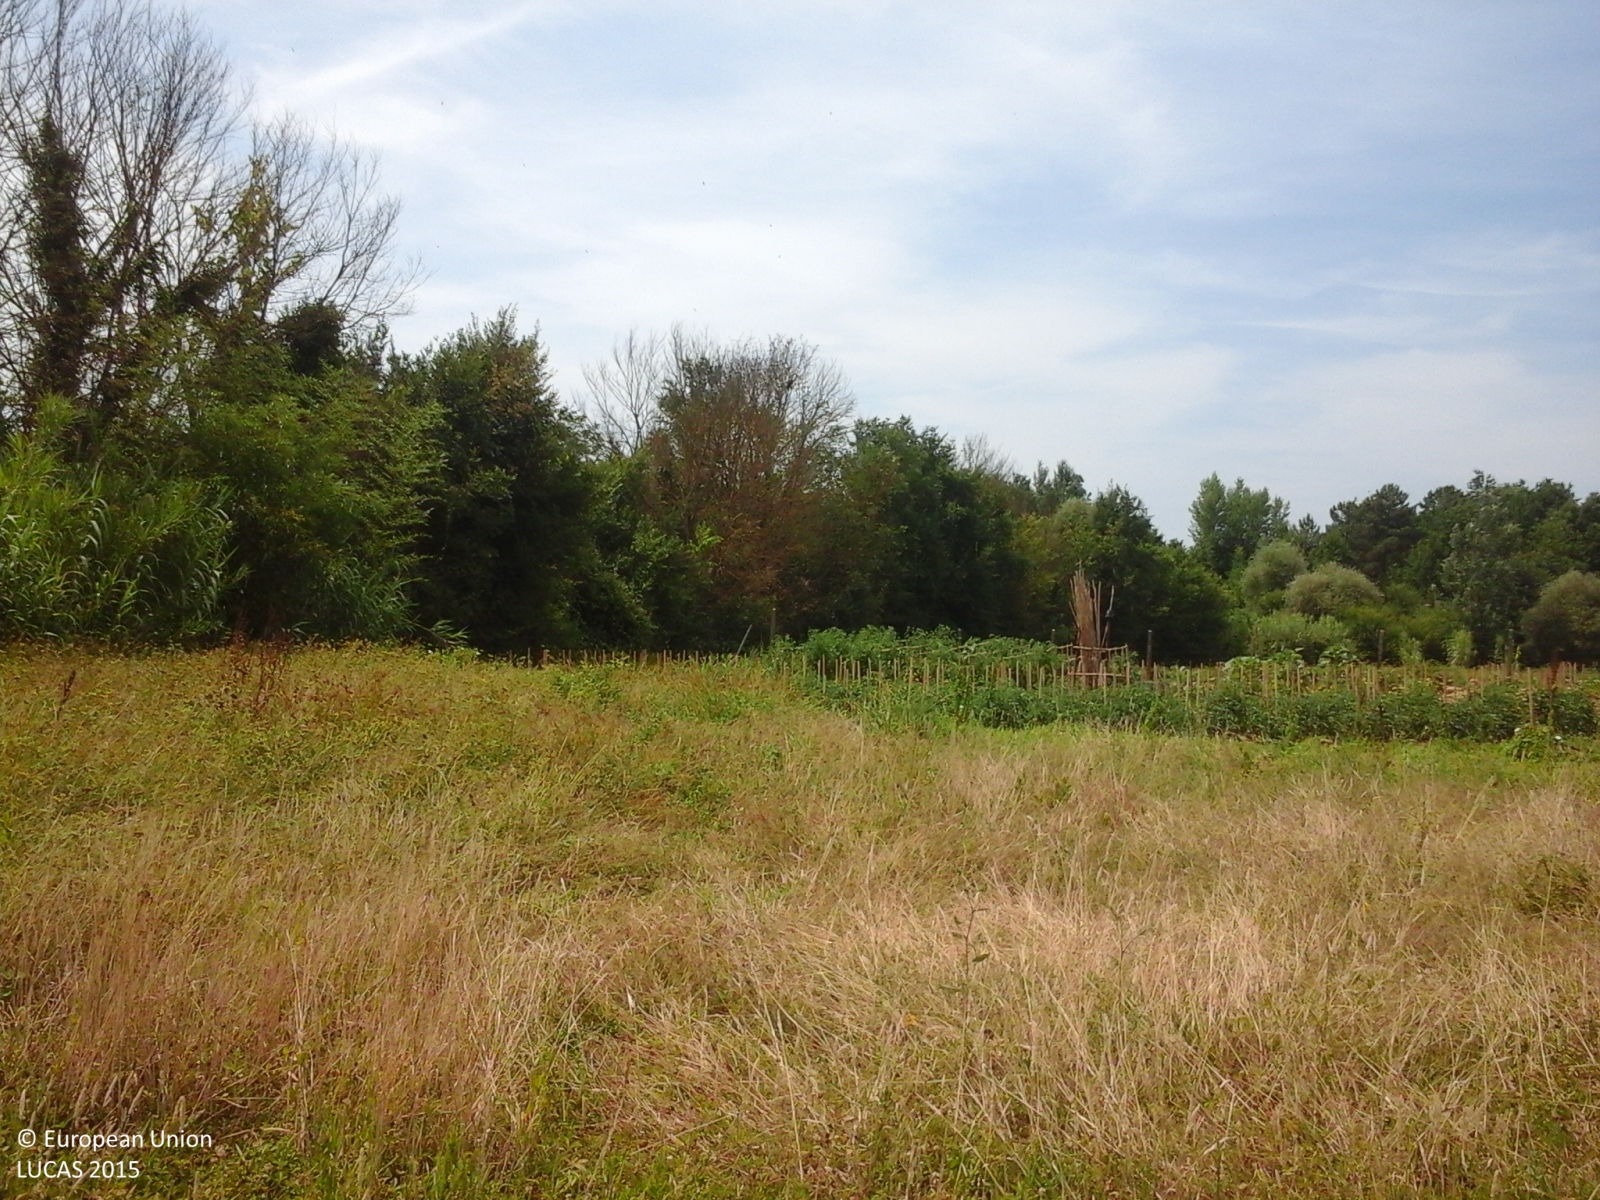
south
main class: Grassland
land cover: Grassland without tree/shrub cover
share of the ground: > 75 %
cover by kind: herbaceous plants 100 %
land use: Agriculture (excluding fallow land and kitchen gardens)
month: June
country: IT
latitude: 43.8056
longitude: 10.8803
